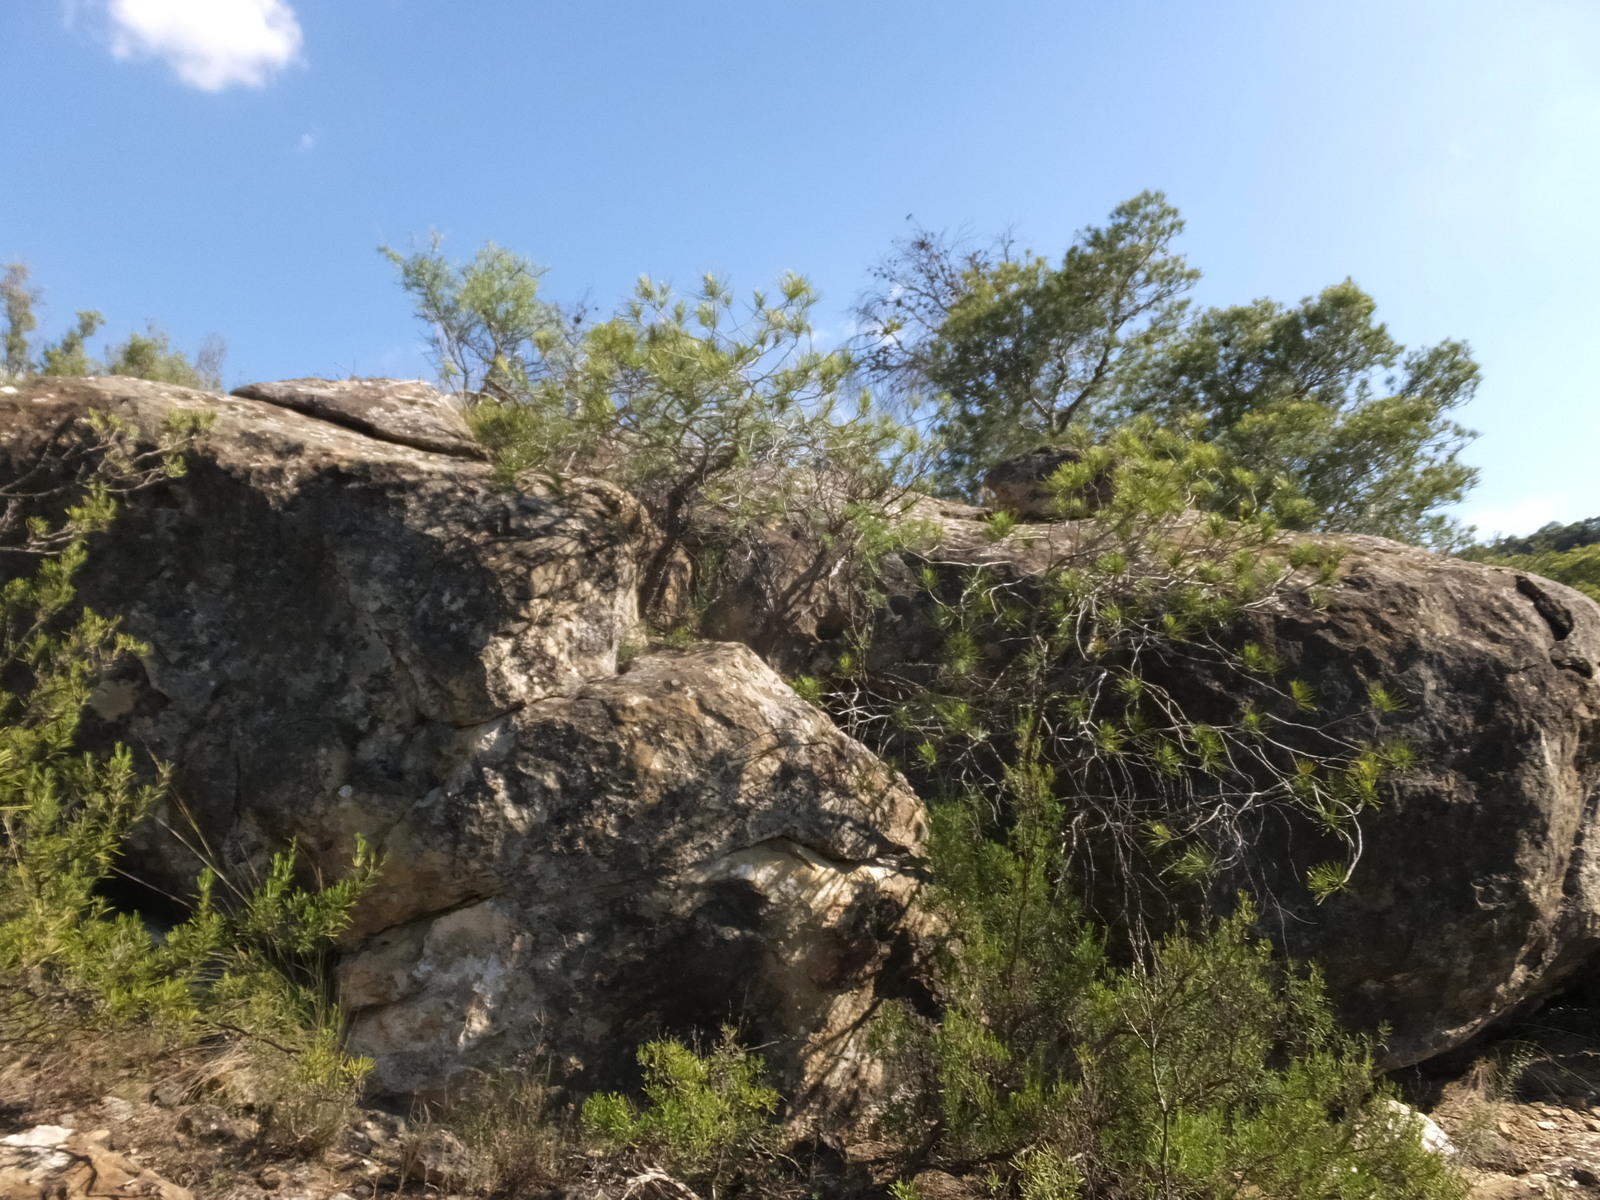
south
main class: Woodland
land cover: Pine dominated mixed woodland
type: coniferous forest of the mediterranean region
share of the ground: 50 - 75 %
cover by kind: coniferous forest trees 60 %, broadleaved forest trees 20 %, shrubs 10 %, herbaceous plants 10 %
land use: Forestry
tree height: > 5 m
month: June
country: ES
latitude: 41.1884
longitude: -0.2308
